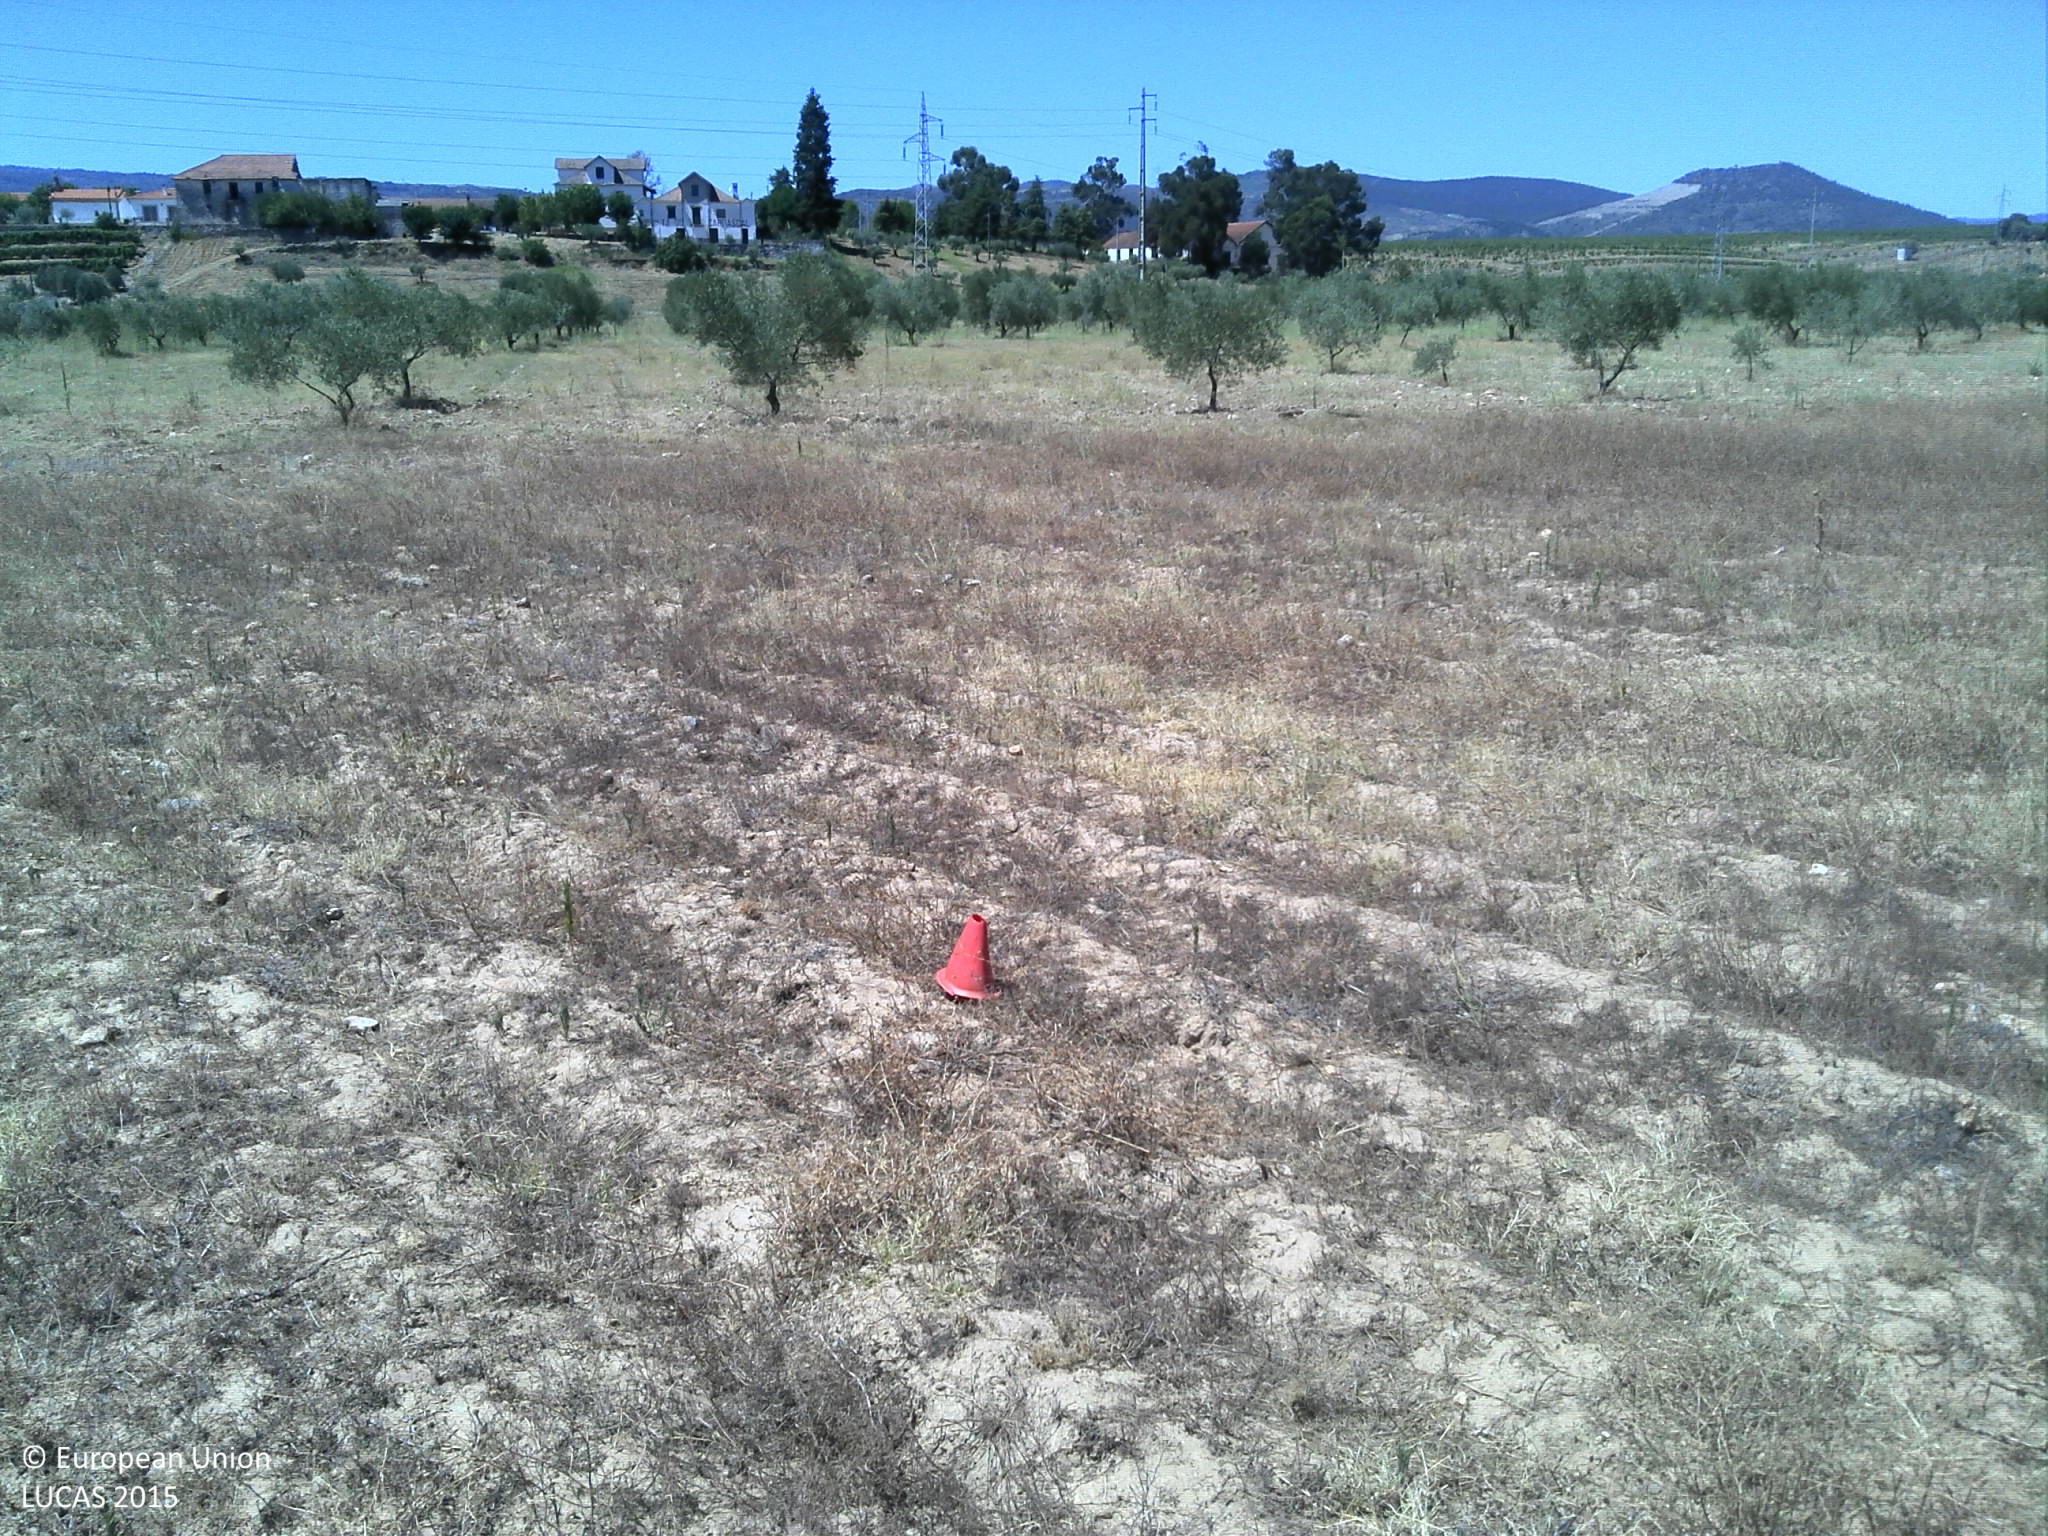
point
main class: Grassland
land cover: Spontaneously vegetated surfaces
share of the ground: 50 - 75 %
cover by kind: herbaceous plants 60 %, unconsolidated bare surface 40 %
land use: Fallow land
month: July
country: PT
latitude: 41.2436
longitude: -7.0929
